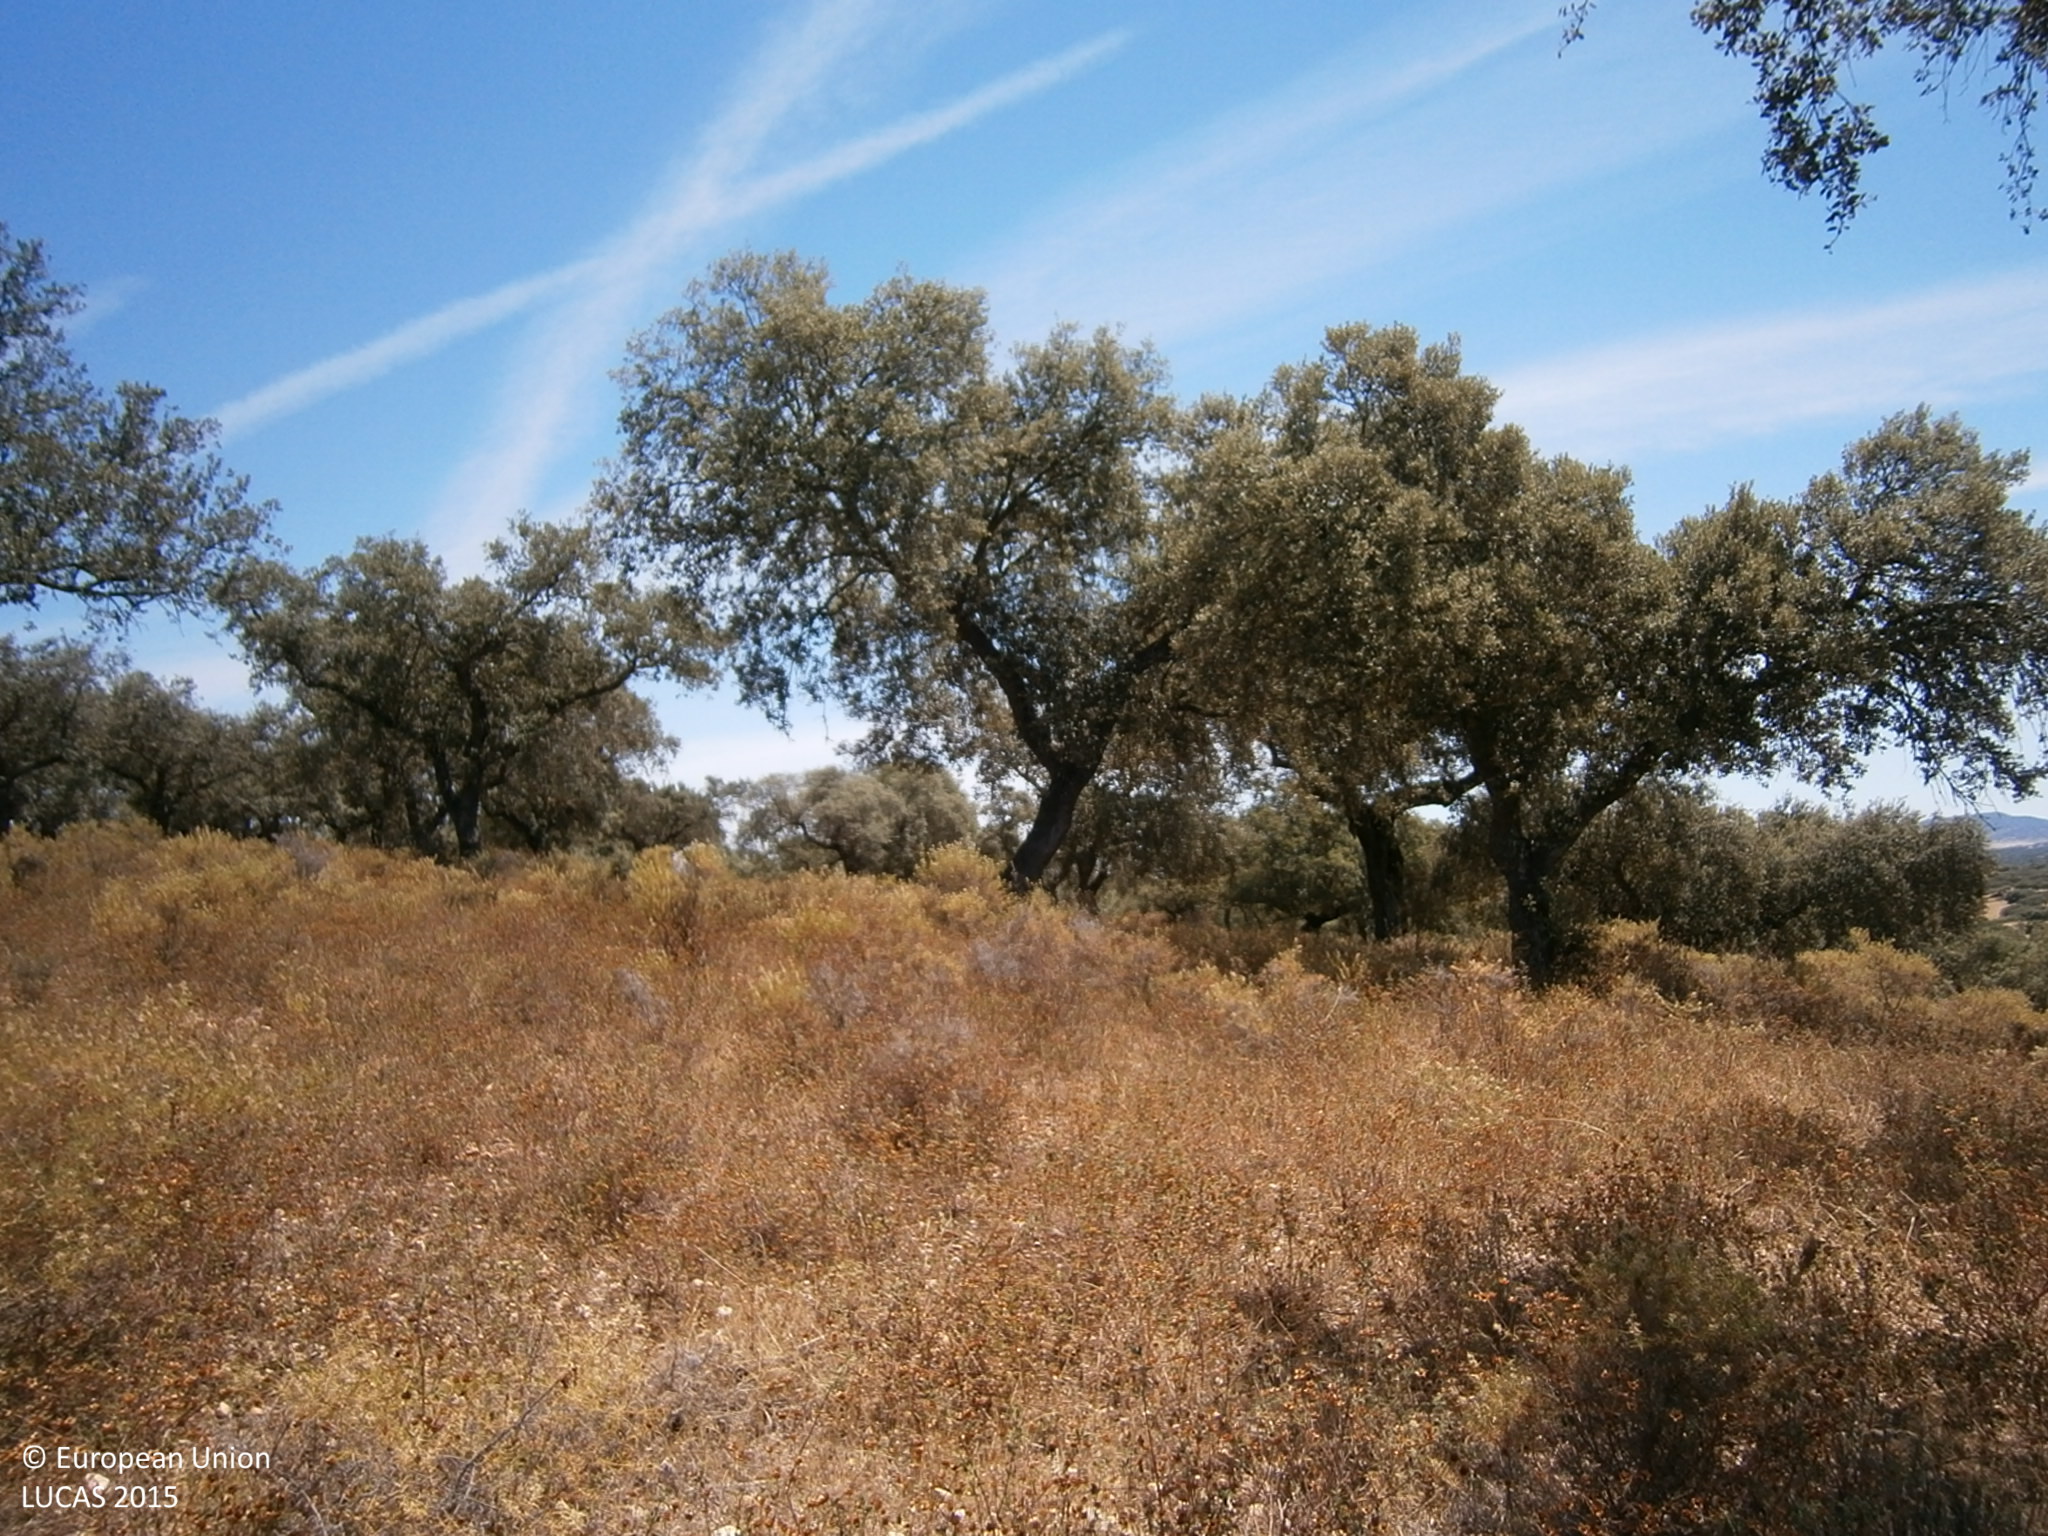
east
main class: Woodland
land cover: Broadleaved woodland
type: broadleaved evergreen forest
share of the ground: 25 - 50 %
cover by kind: shrubs 55 %, broadleaved forest trees 45 %
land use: Forestry
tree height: > 5 m
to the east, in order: Broadleaved woodland
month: July
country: ES
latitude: 38.6348
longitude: -7.2456
